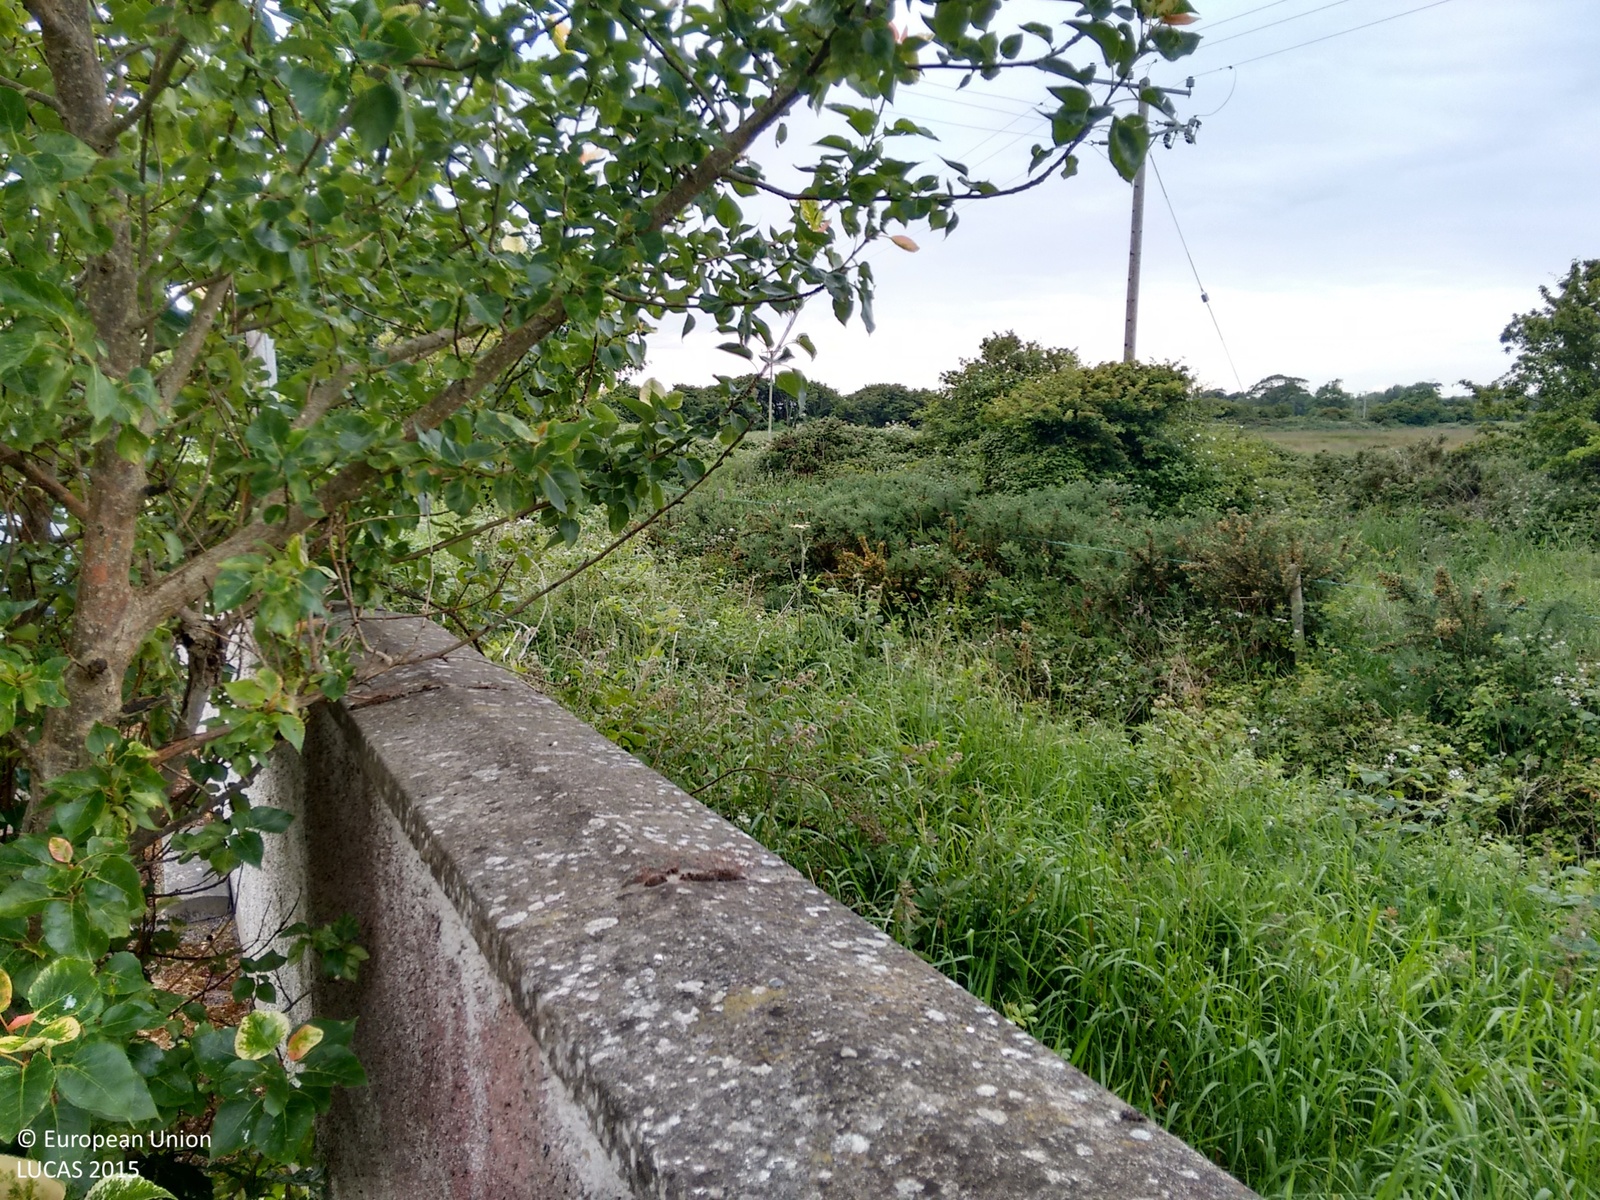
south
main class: Grassland
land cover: Grassland without tree/shrub cover
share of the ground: > 75 %
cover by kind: herbaceous plants 100 %
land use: Agriculture (excluding fallow land and kitchen gardens)
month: June
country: IE
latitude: 53.7074
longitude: -6.2533
